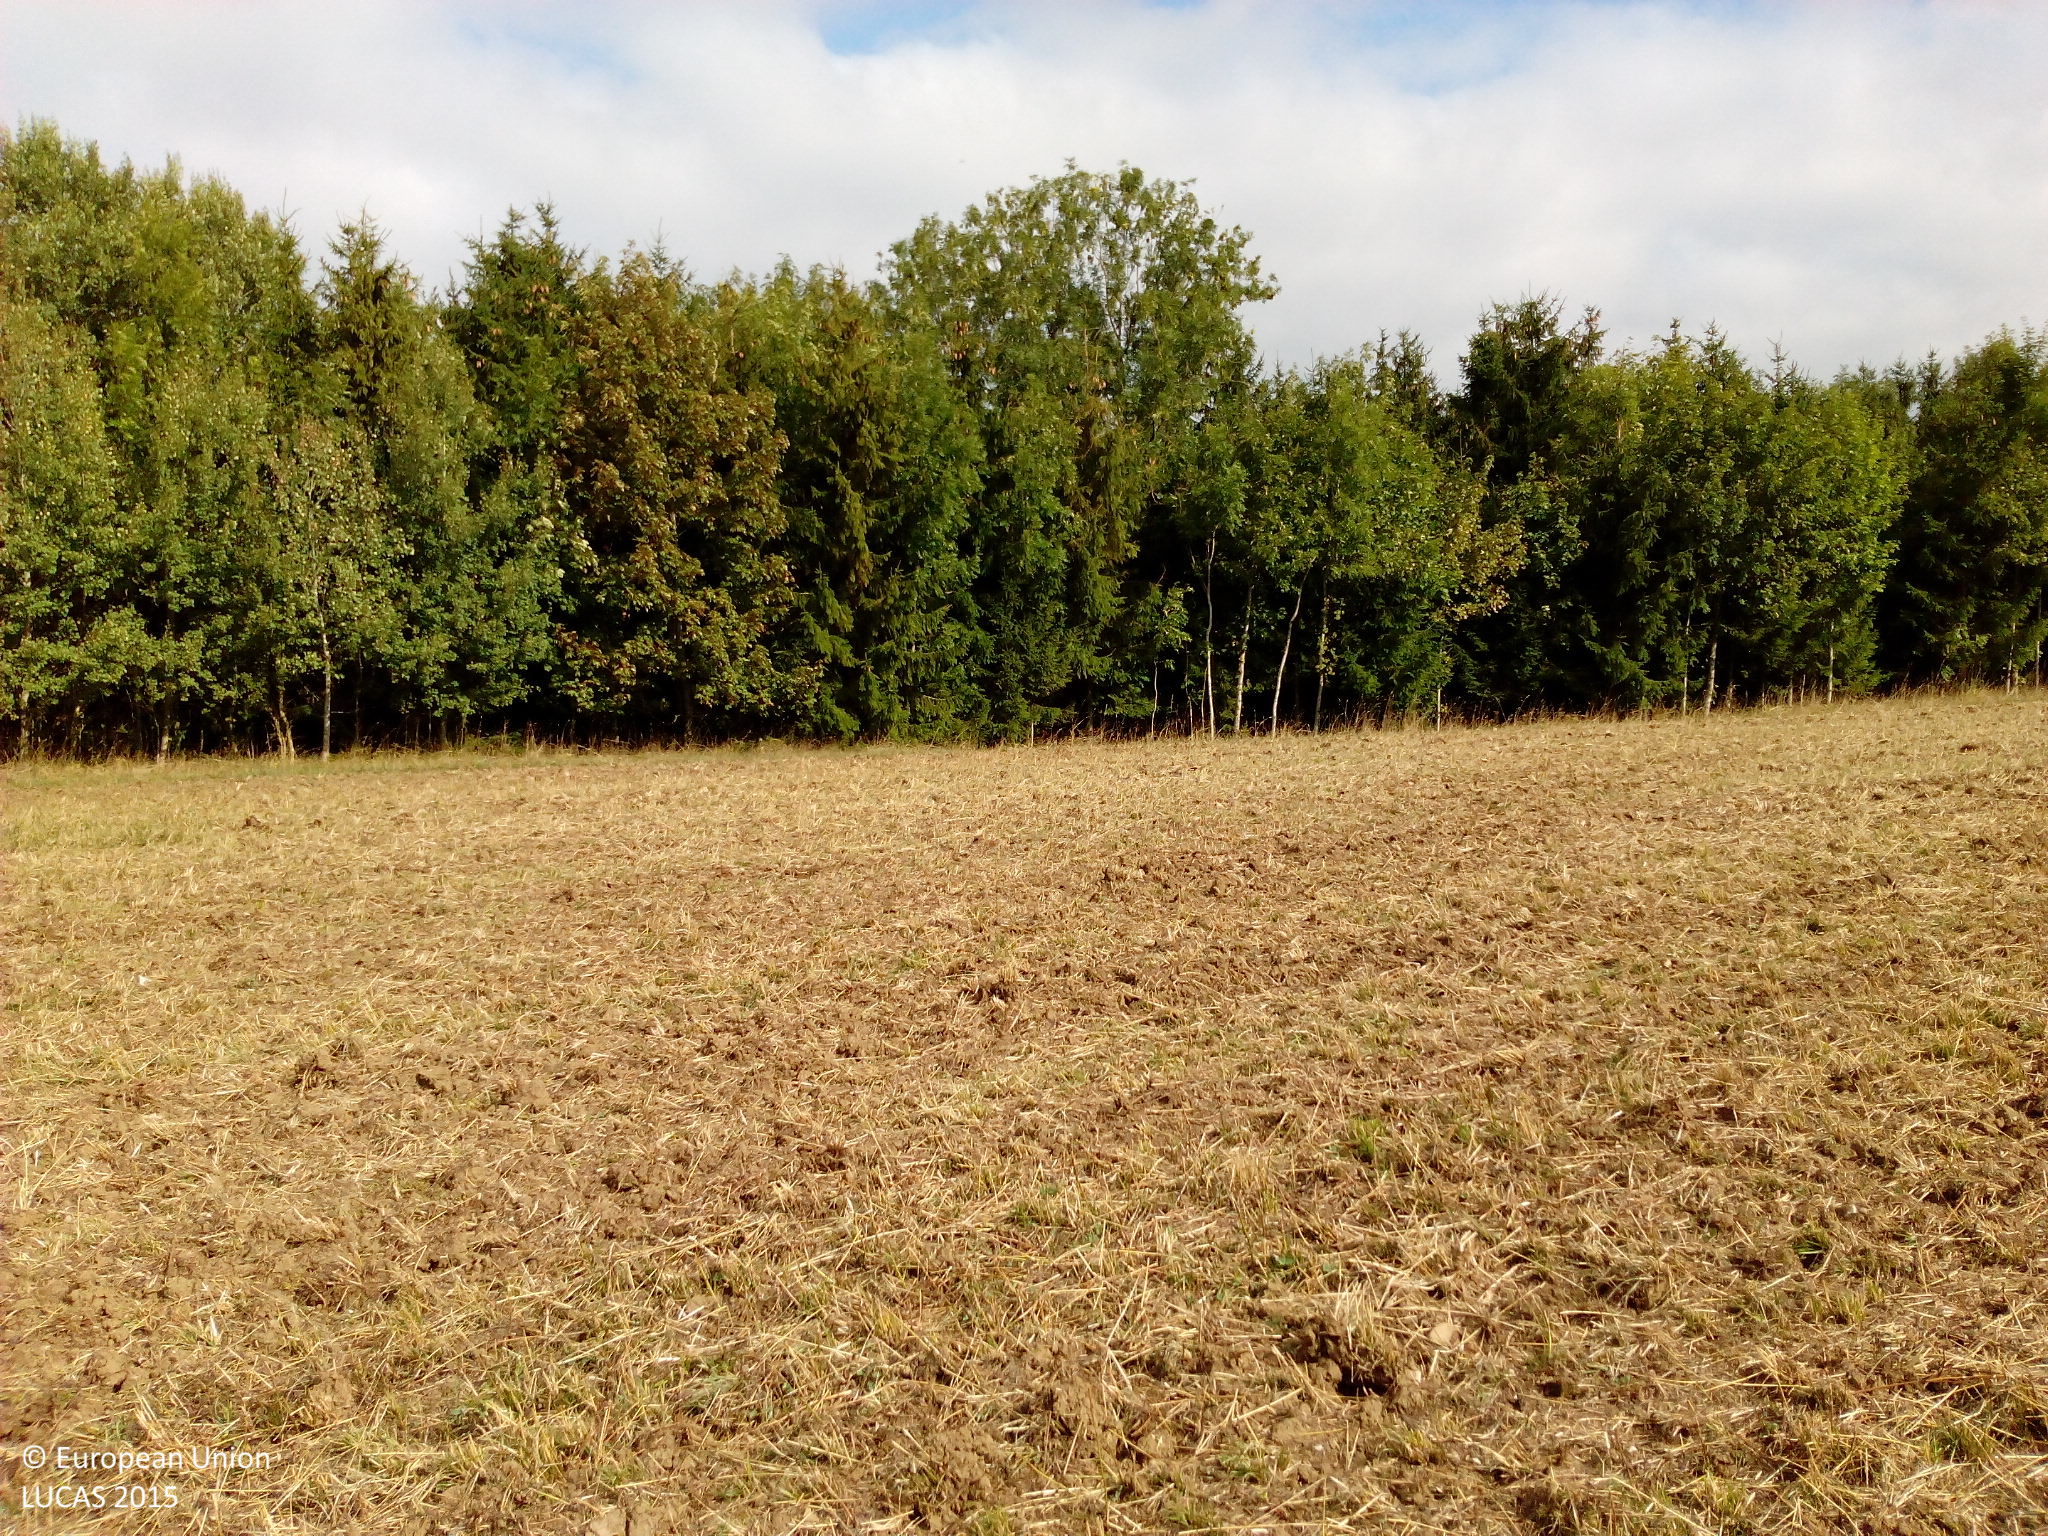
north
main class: Cropland
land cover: Temporary grasslands
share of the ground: 10 - 25 %
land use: Agriculture (excluding fallow land and kitchen gardens)
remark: Harvested field
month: September
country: DE
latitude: 48.2701
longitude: 8.7208
